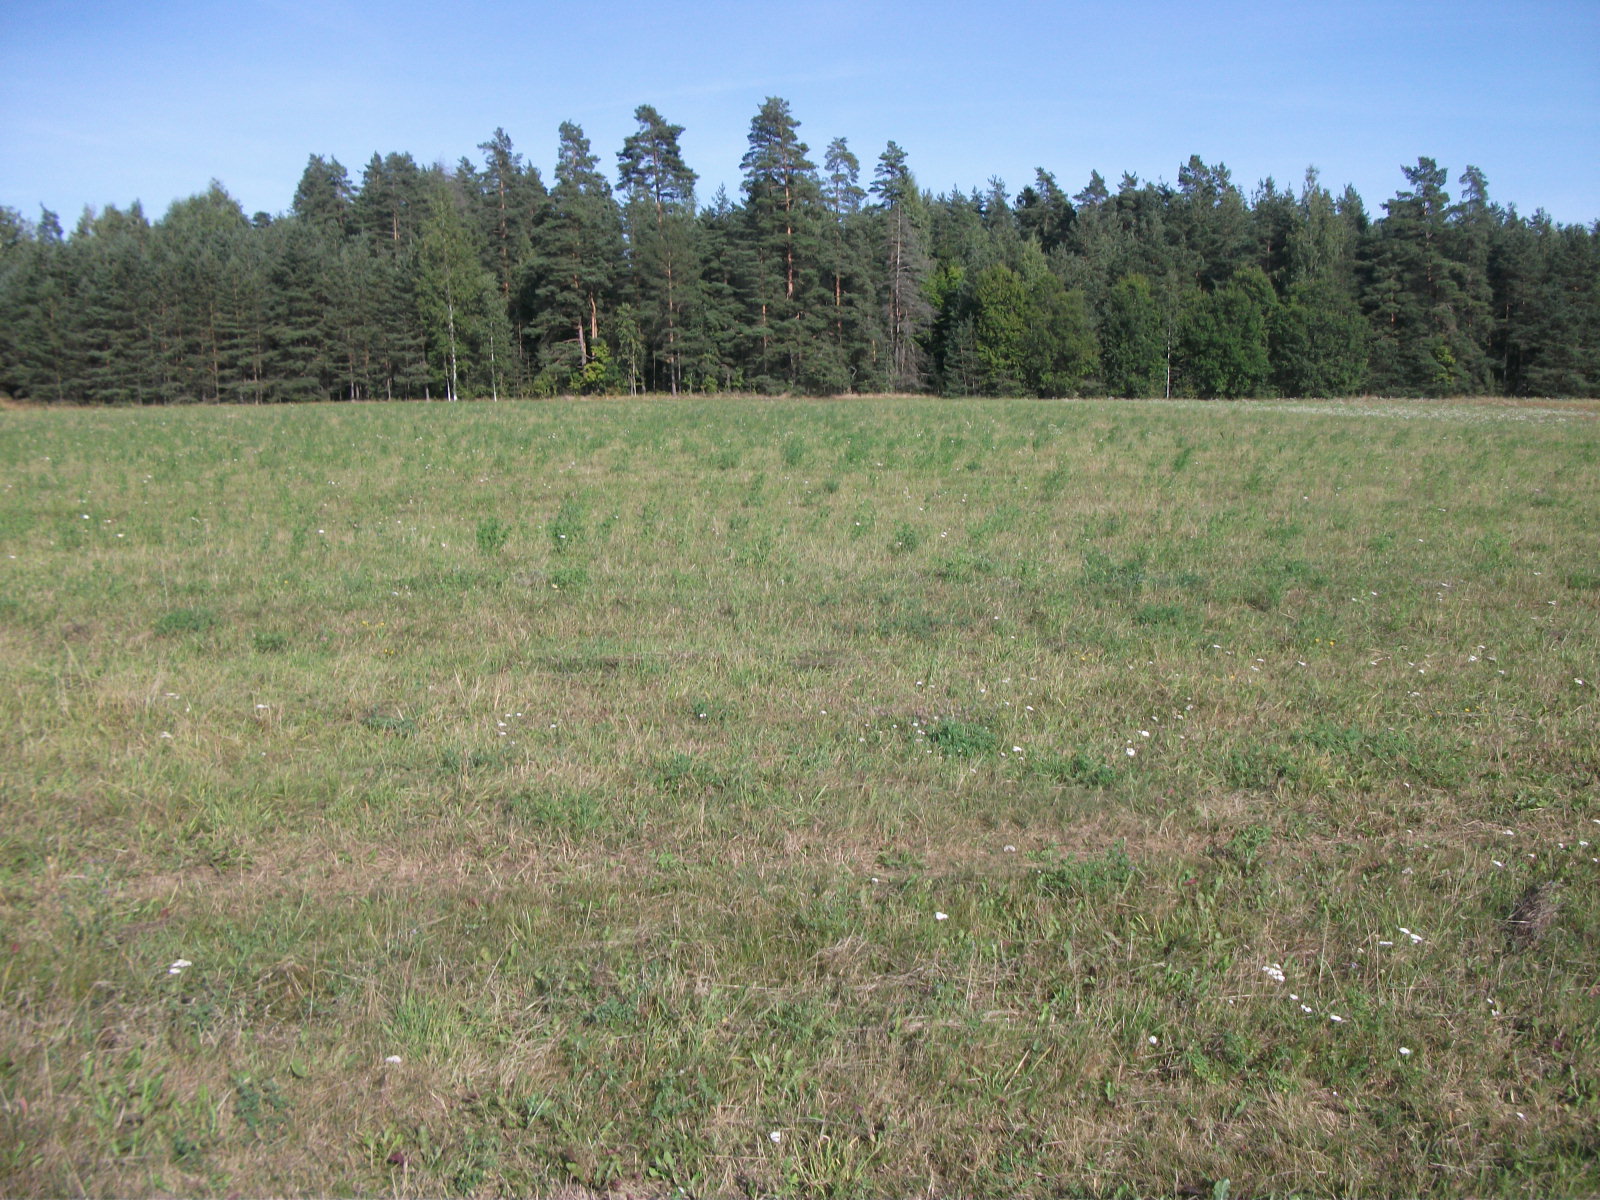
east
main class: Grassland
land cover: Grassland without tree/shrub cover
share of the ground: > 75 %
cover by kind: herbaceous plants 100 %
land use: Agriculture (excluding fallow land and kitchen gardens)
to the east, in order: Grassland without tree/shrub cover; Pine dominated mixed woodland; Tracks; Pine dominated mixed woodland
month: August
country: LV
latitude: 56.3077
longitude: 26.1902
